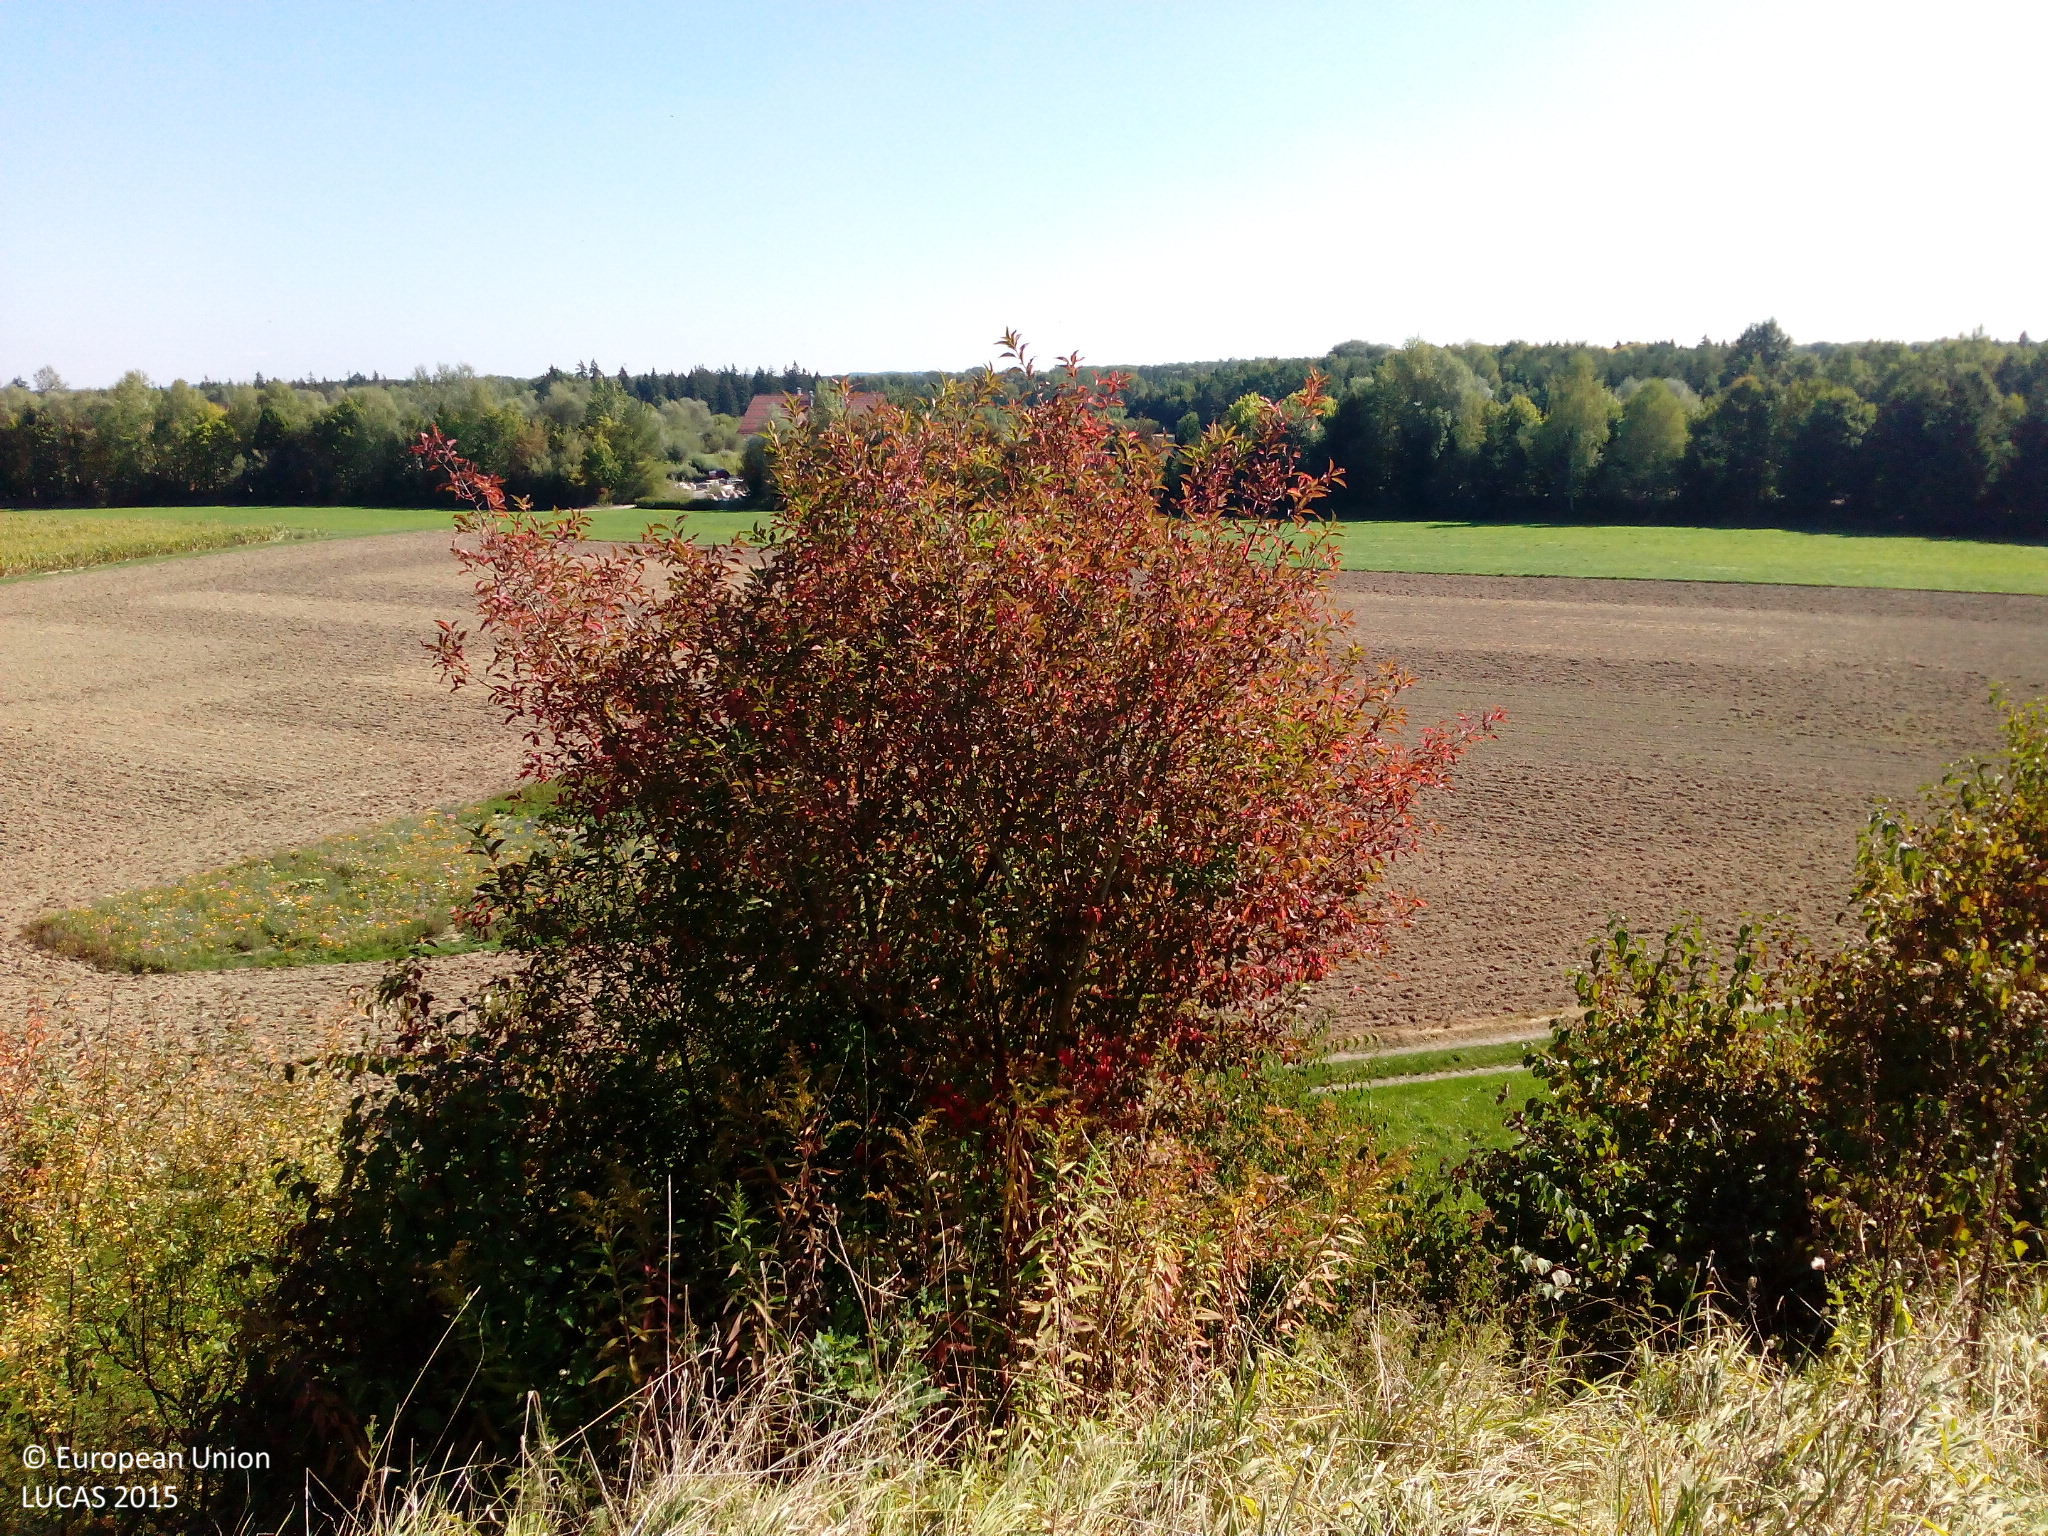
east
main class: Shrubland
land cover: Shrubland with sparse tree cover
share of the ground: 50 - 75 %
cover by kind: shrubs 60 %, herbaceous plants 35 %, broadleaved forest trees 5 %
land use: Semi-natural and natural areas not in use
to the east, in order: Shrubland with sparse tree cover; Grassland without tree/shrub cover; Tracks; Grass margins; Other bare soil; Other leguminous and mixtures for fodder; Other bare soil; Artificial constructions in urban areas
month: September
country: DE
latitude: 48.4411
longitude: 11.9052
